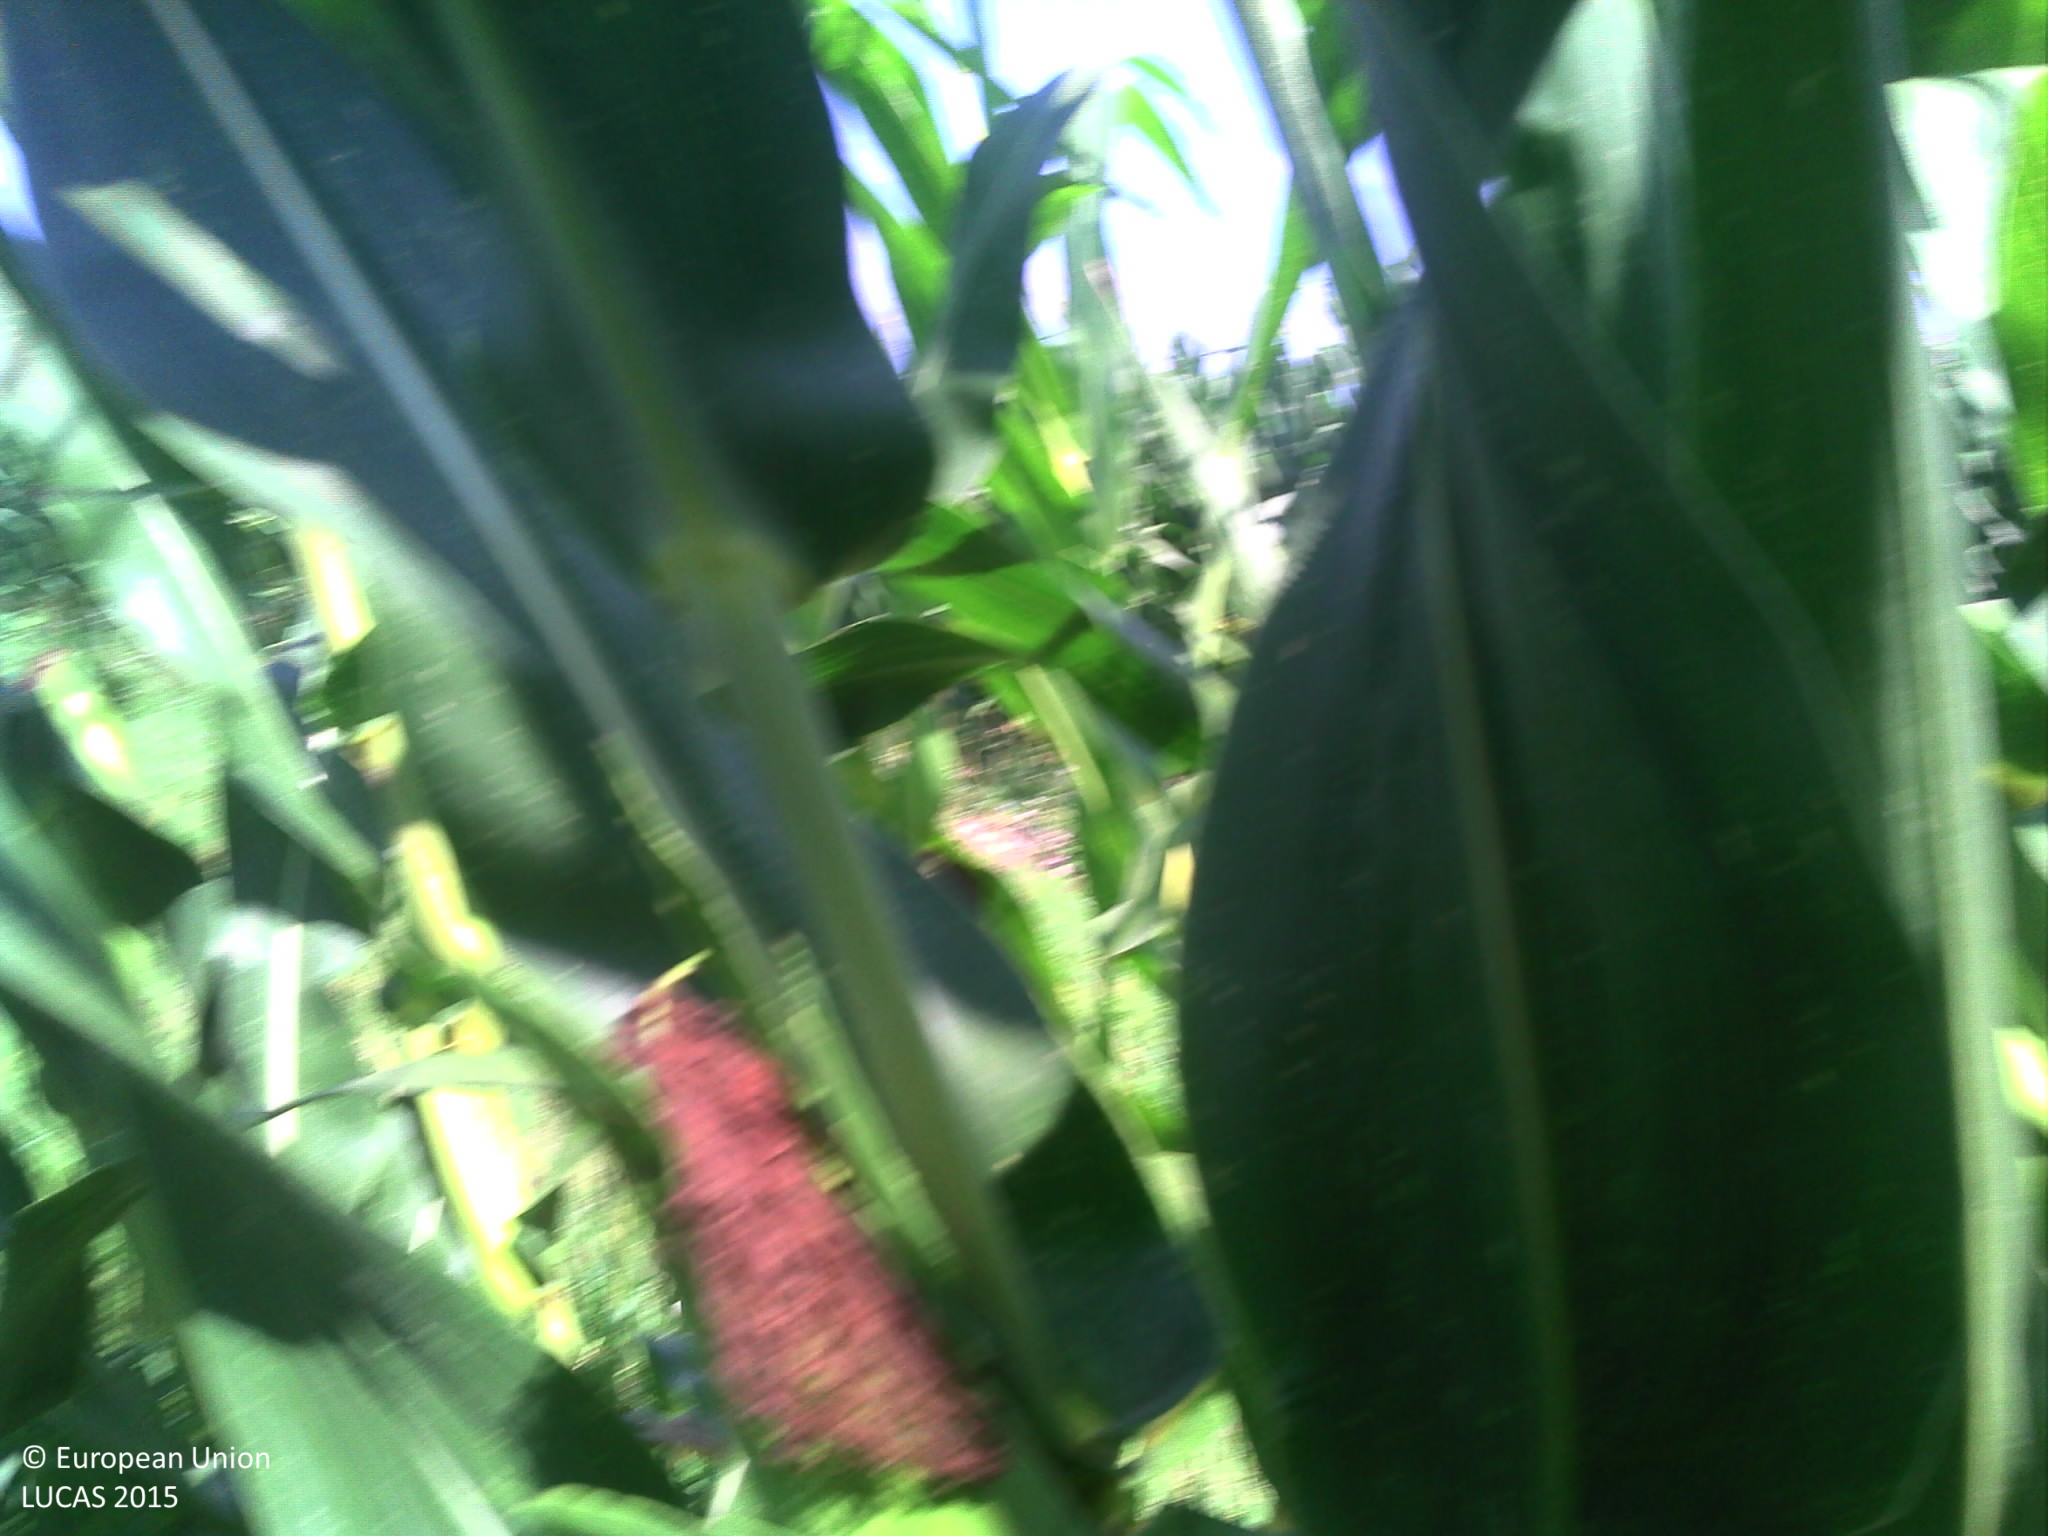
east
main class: Cropland
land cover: Maize
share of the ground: > 75 %
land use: Agriculture (excluding fallow land and kitchen gardens)
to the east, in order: Maize; Grass margins; Tracks; Grass margins; Ditches and canals; Maize; Artificial constructions in urban areas
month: August
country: FR
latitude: 44.0350
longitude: 1.2521
